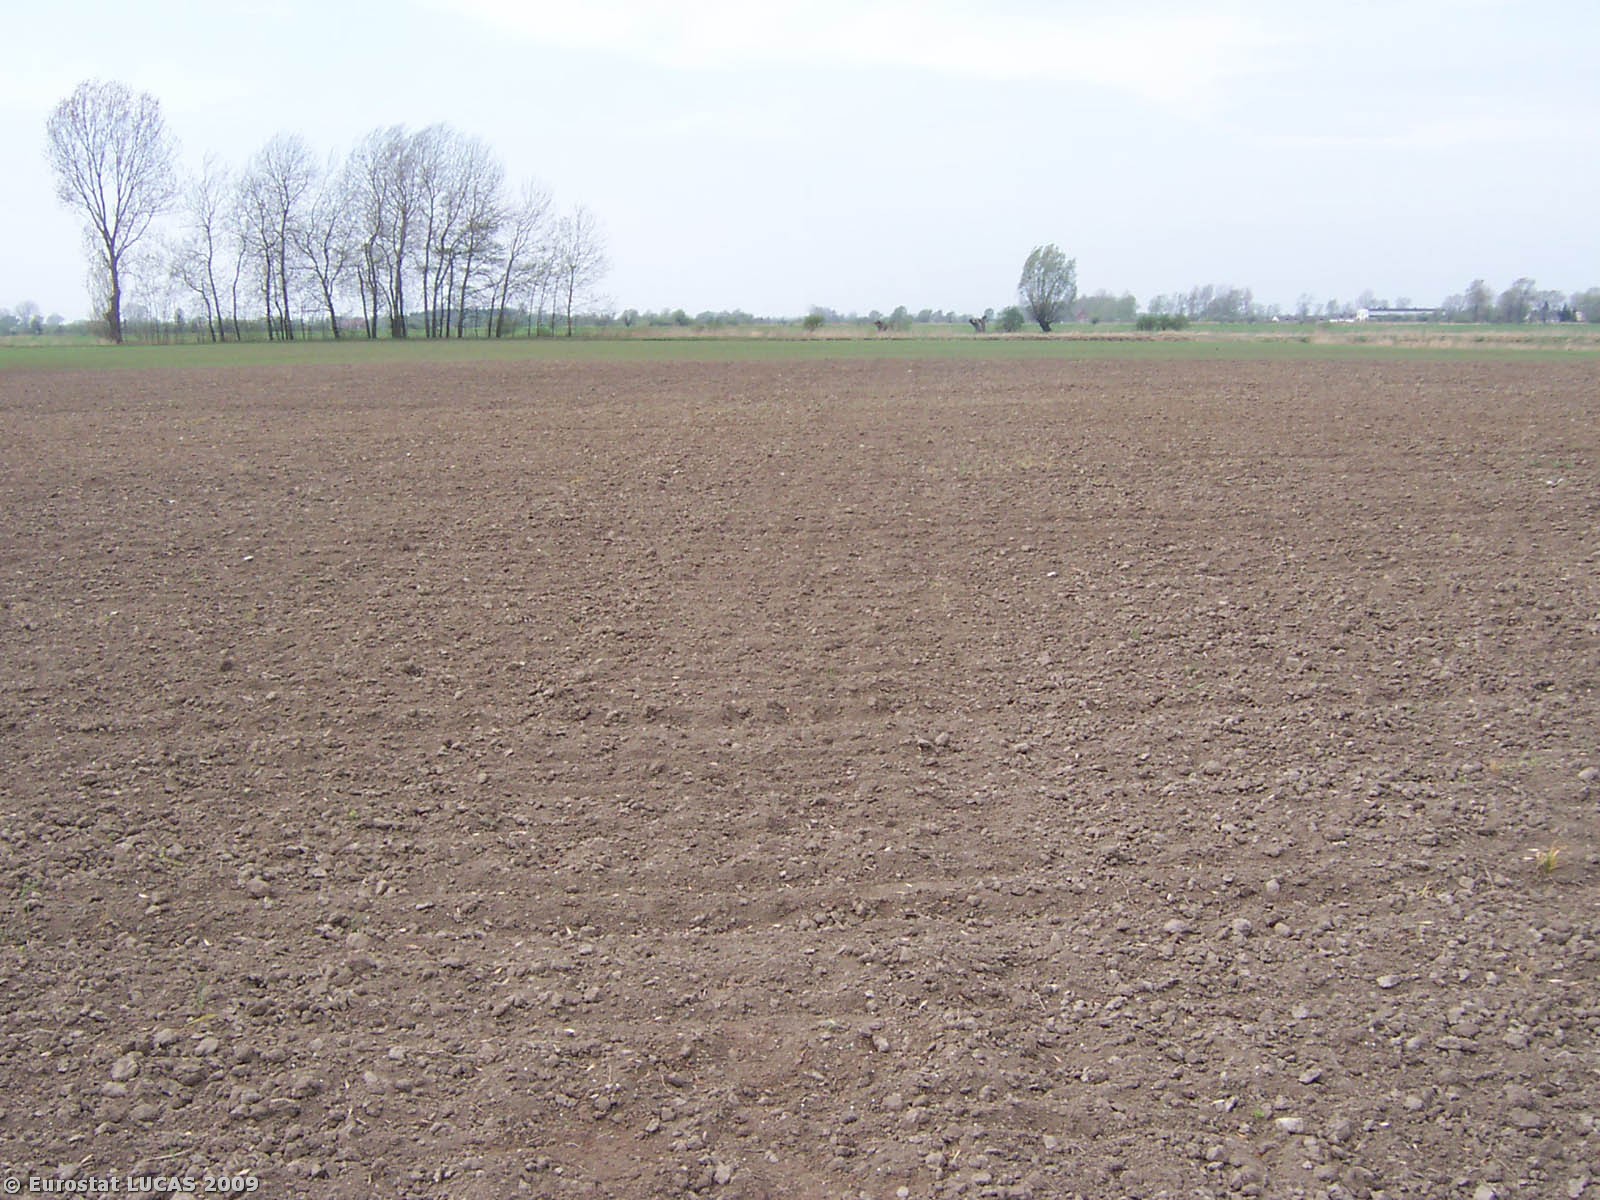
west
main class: Cropland
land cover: Sugar beet
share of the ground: < 10 %
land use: Agriculture (excluding fallow land and kitchen gardens)
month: April
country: PL
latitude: 54.2247
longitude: 18.9942
